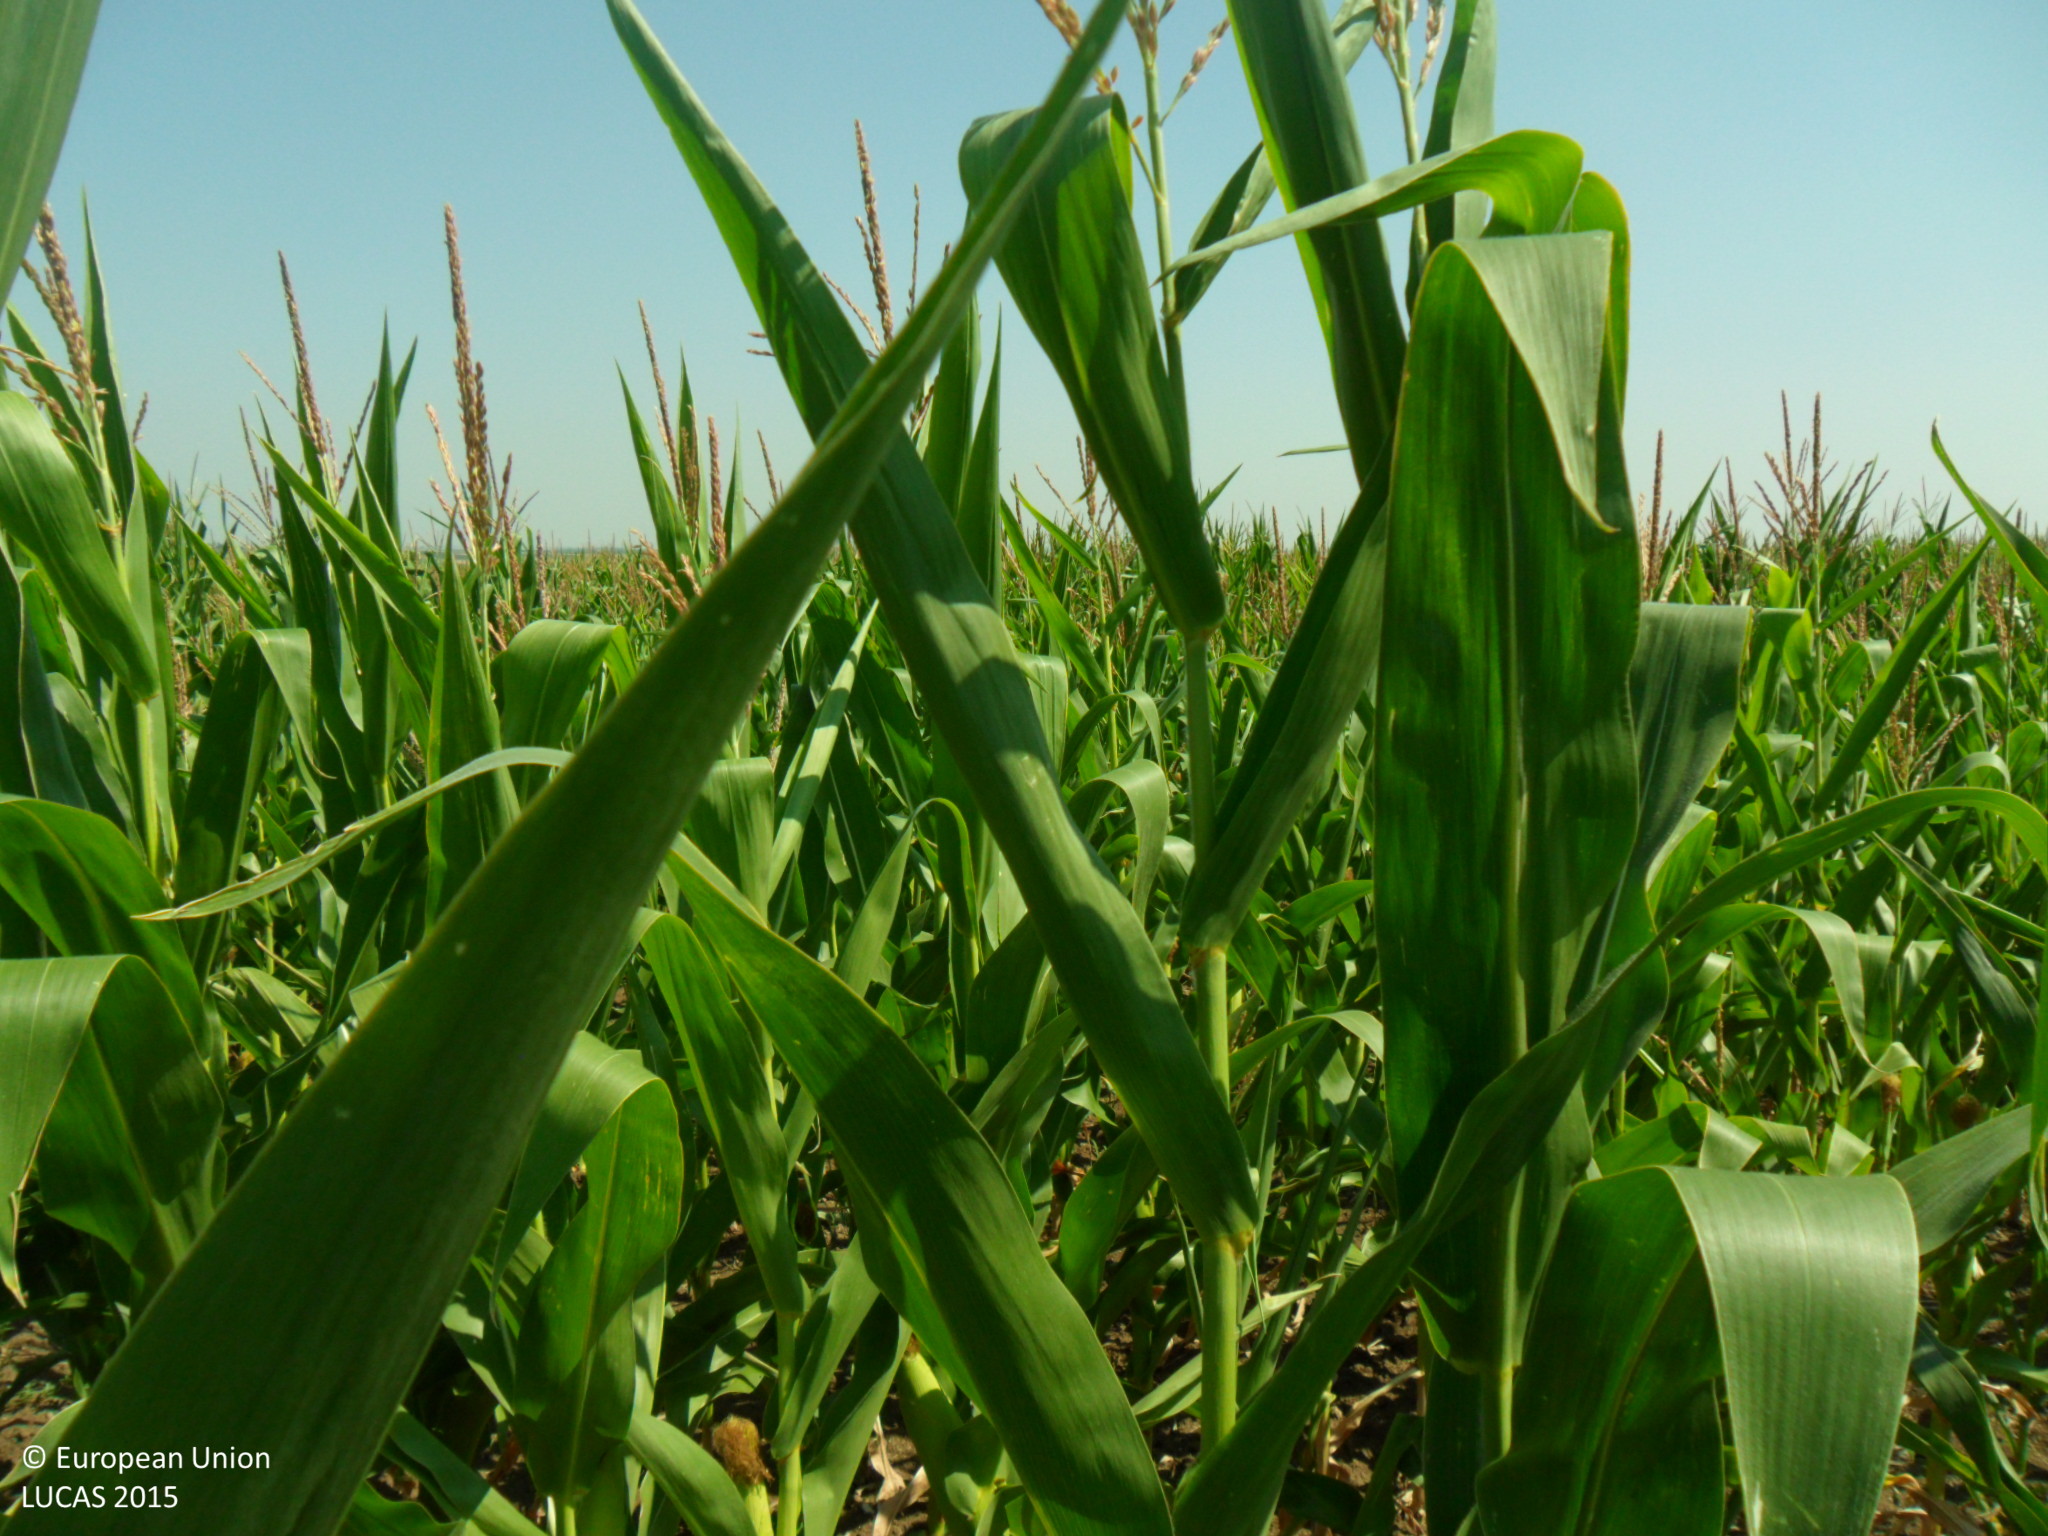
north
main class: Cropland
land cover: Maize
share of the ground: > 75 %
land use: Agriculture (excluding fallow land and kitchen gardens)
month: July
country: BG
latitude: 43.6005
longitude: 27.3092
